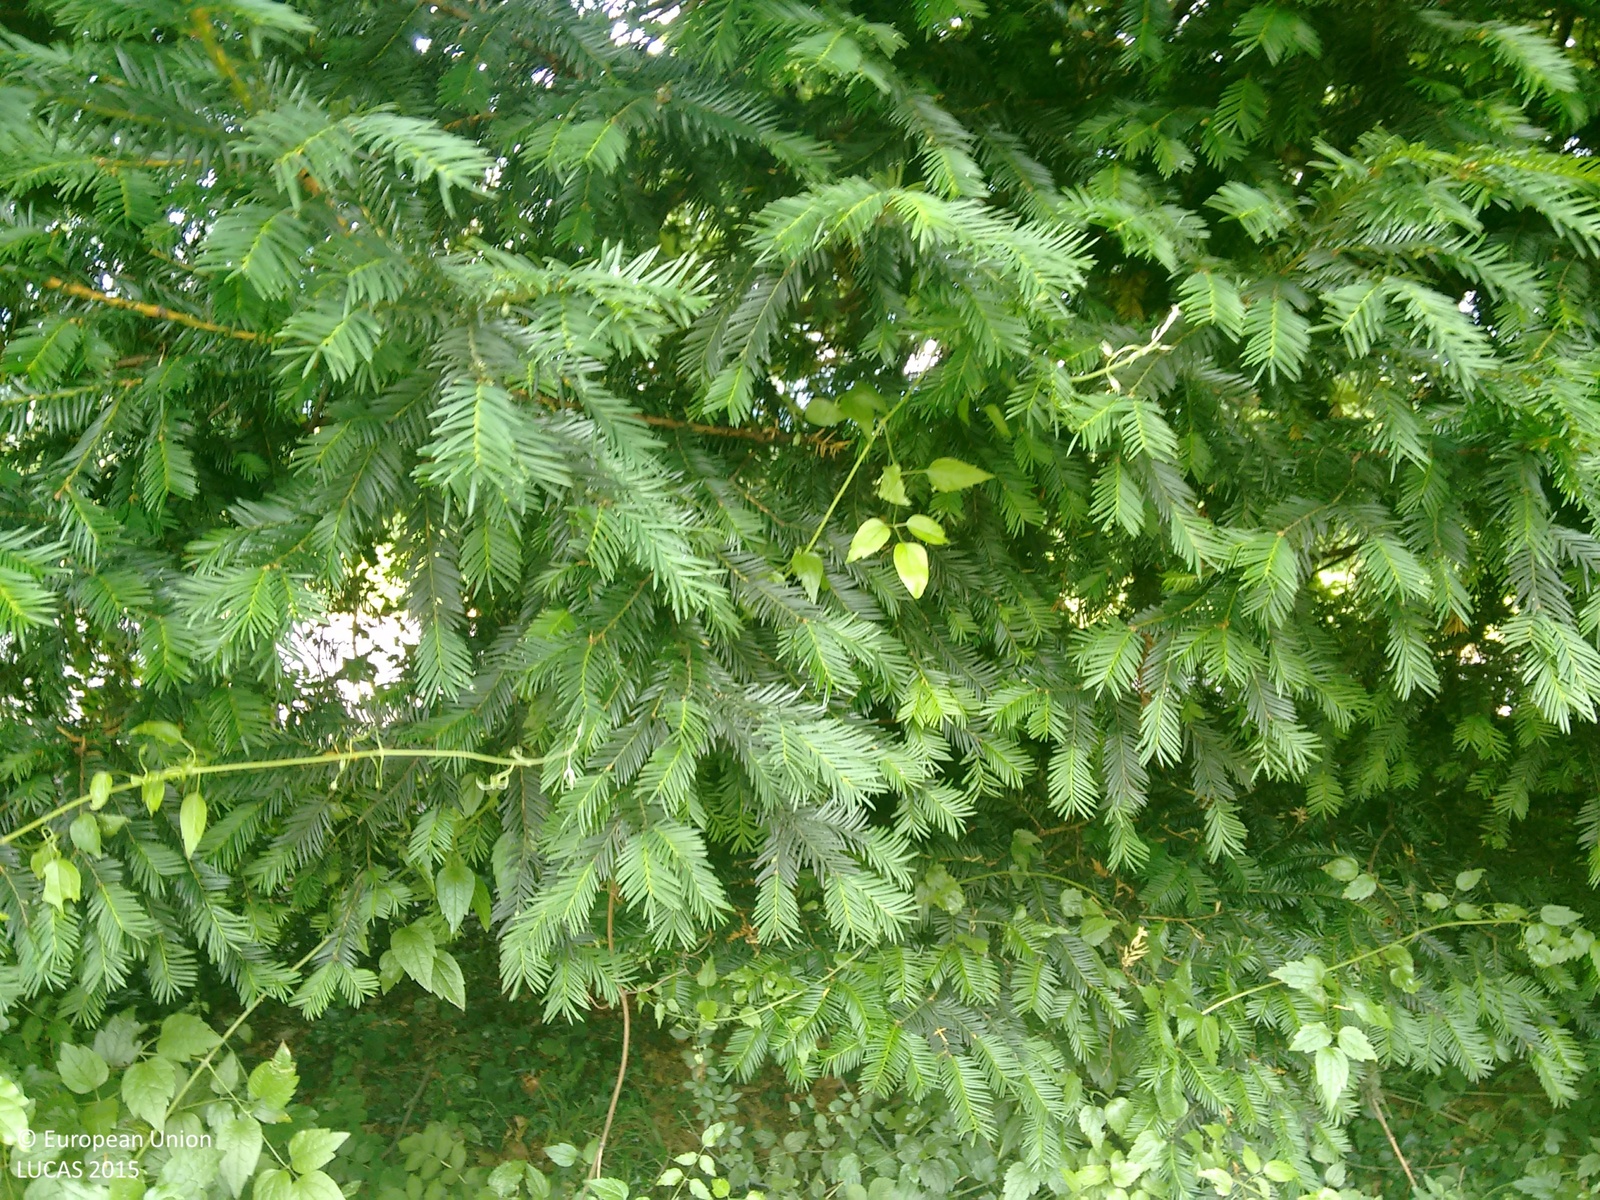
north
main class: Woodland
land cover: Other mixed woodland
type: hemiboreal forest and nemoral coniferous forest and mixed broadleaved-coniferous forest
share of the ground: > 75 %
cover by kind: coniferous forest trees 50 %, broadleaved forest trees 50 %
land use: Road transport
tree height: > 5 m
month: July
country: GB
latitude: 51.2283
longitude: -0.6225
